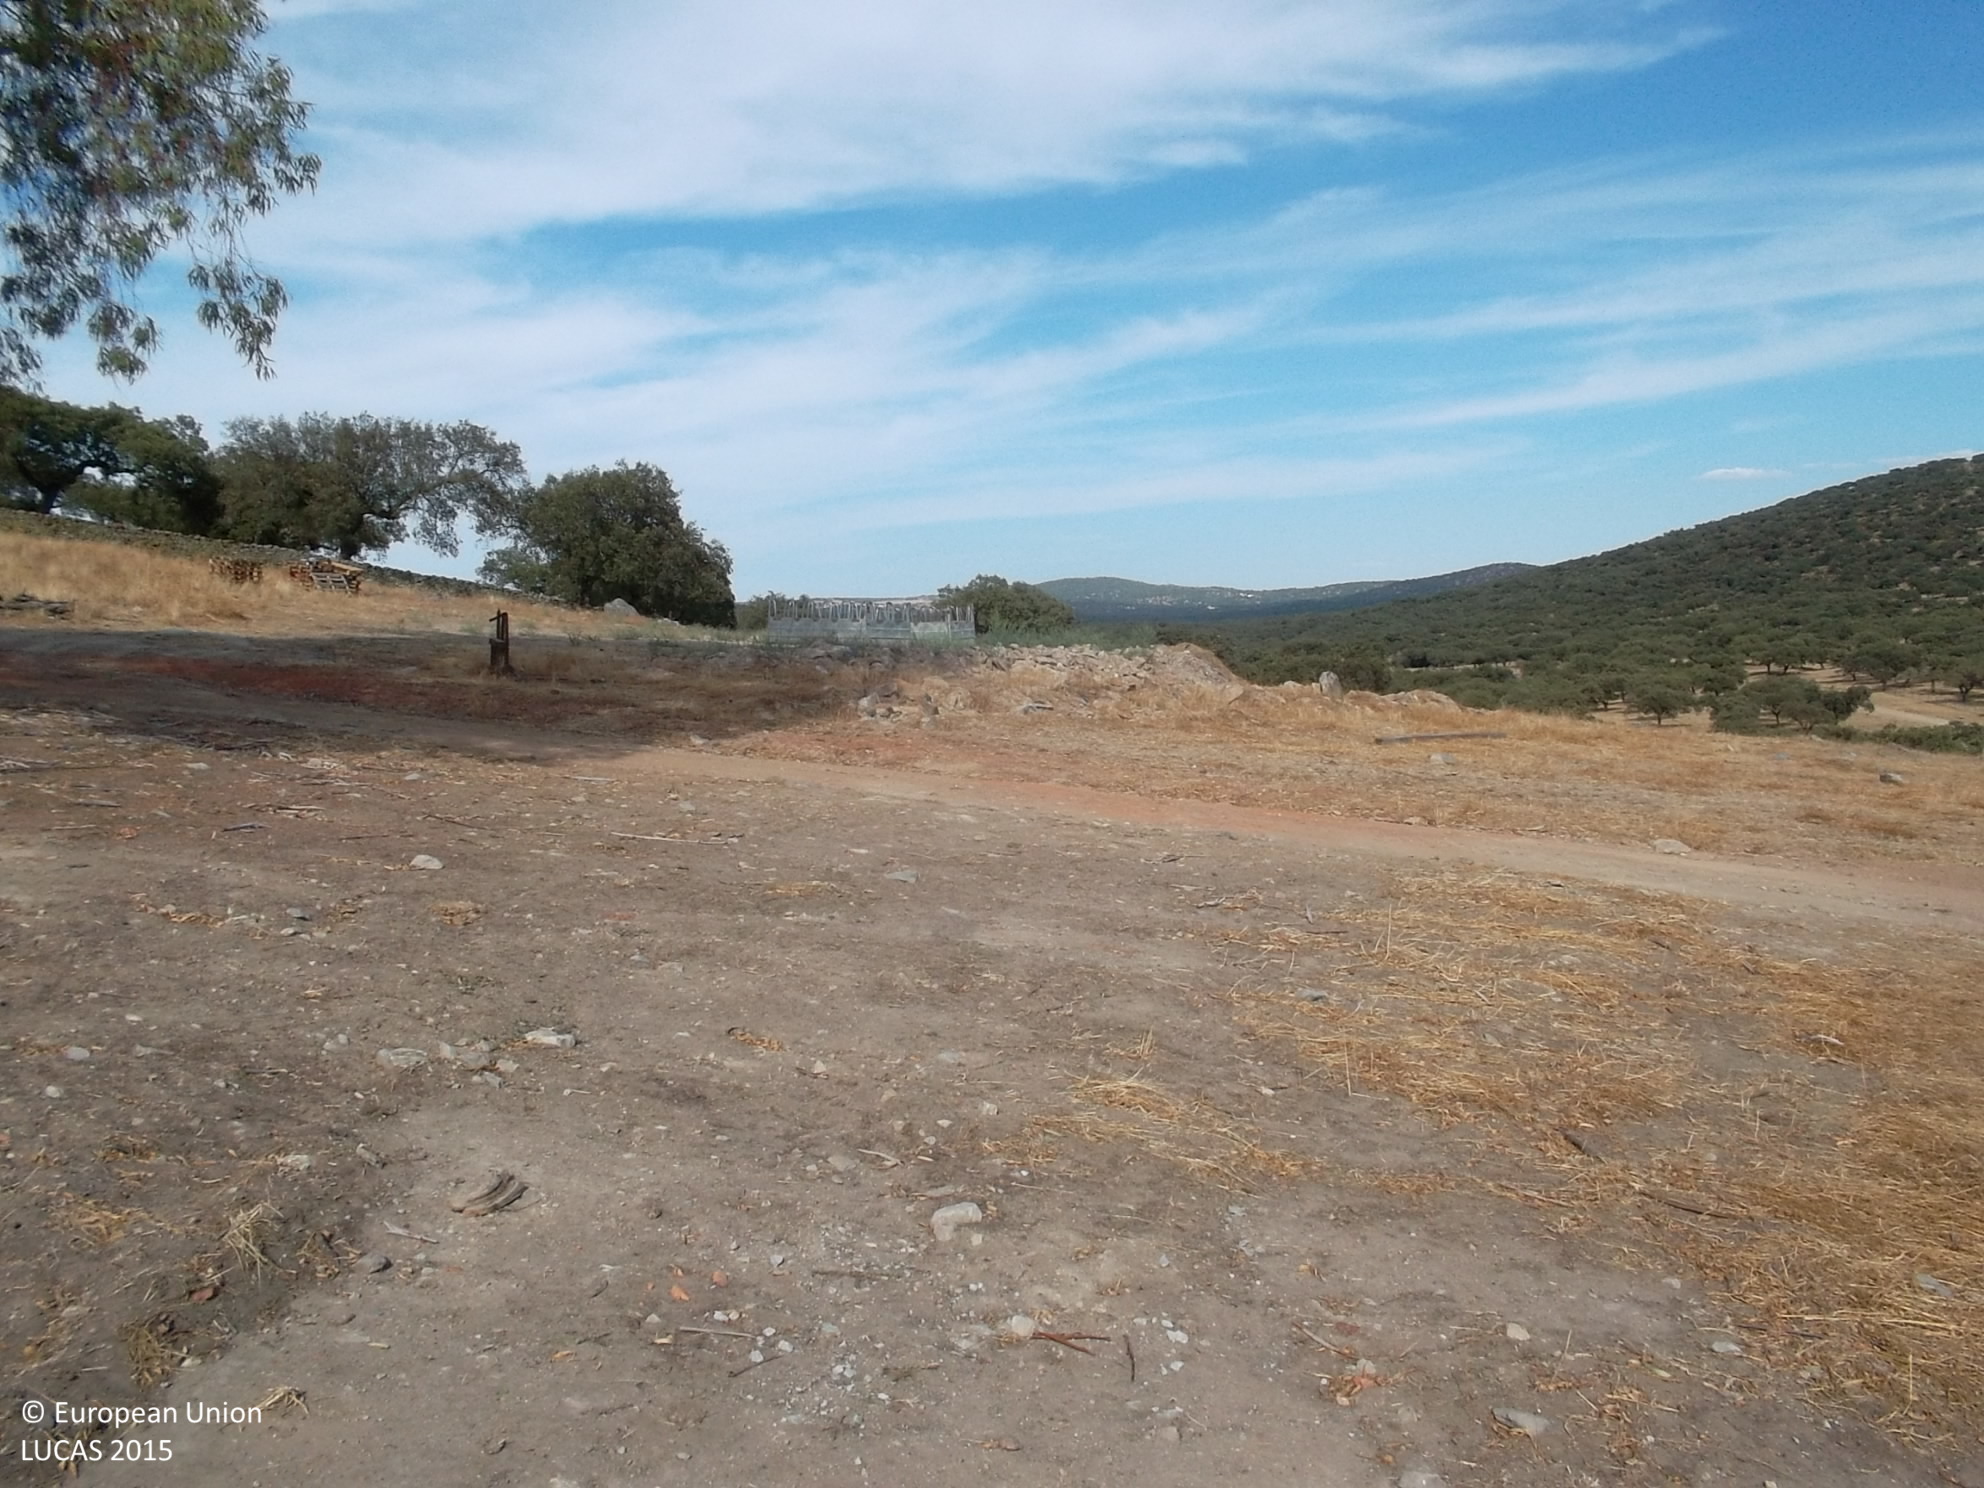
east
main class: Grassland
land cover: Grassland without tree/shrub cover
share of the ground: > 75 %
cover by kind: herbaceous plants 100 %
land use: Agriculture (excluding fallow land and kitchen gardens)
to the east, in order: Grassland without tree/shrub cover; Artificial constructions in urban areas; Grassland without tree/shrub cover; Dry stone walls; Broadleaved woodland; Tracks; Broadleaved woodland
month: August
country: ES
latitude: 38.1444
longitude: -6.7916
